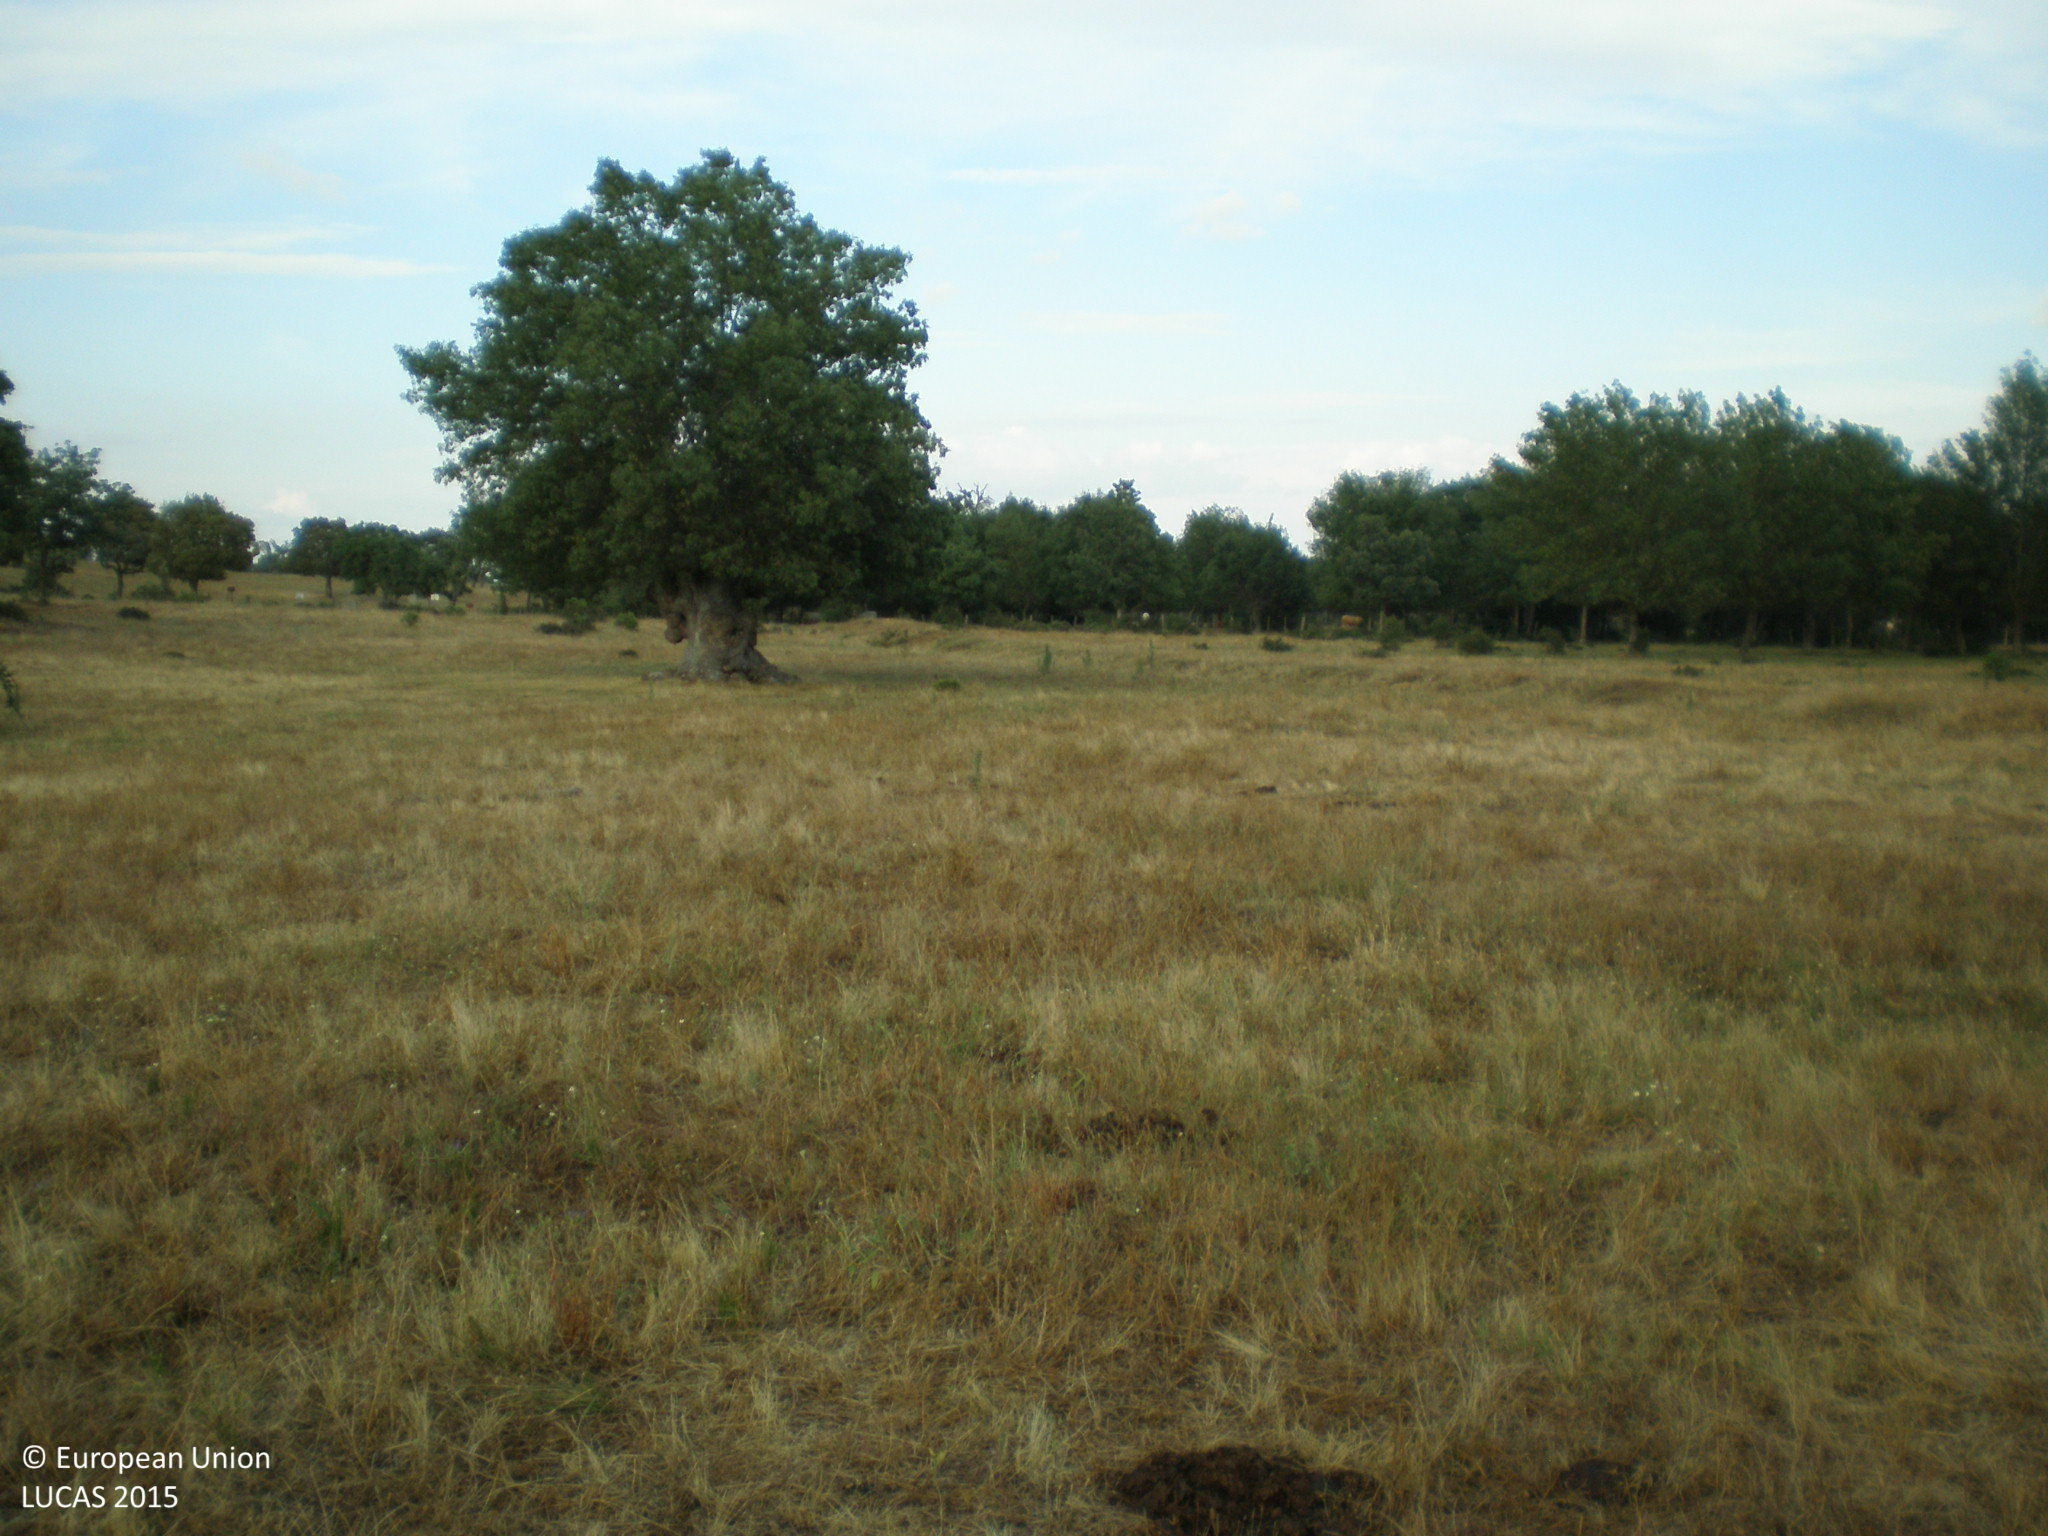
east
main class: Grassland
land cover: Grassland without tree/shrub cover
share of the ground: > 75 %
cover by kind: herbaceous plants 100 %
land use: Agriculture (excluding fallow land and kitchen gardens)
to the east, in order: Grassland without tree/shrub cover; Grassland with sparse tree/shrub cover; Fences; Grassland with sparse tree/shrub cover
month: June
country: ES
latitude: 41.2082
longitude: -5.7655
